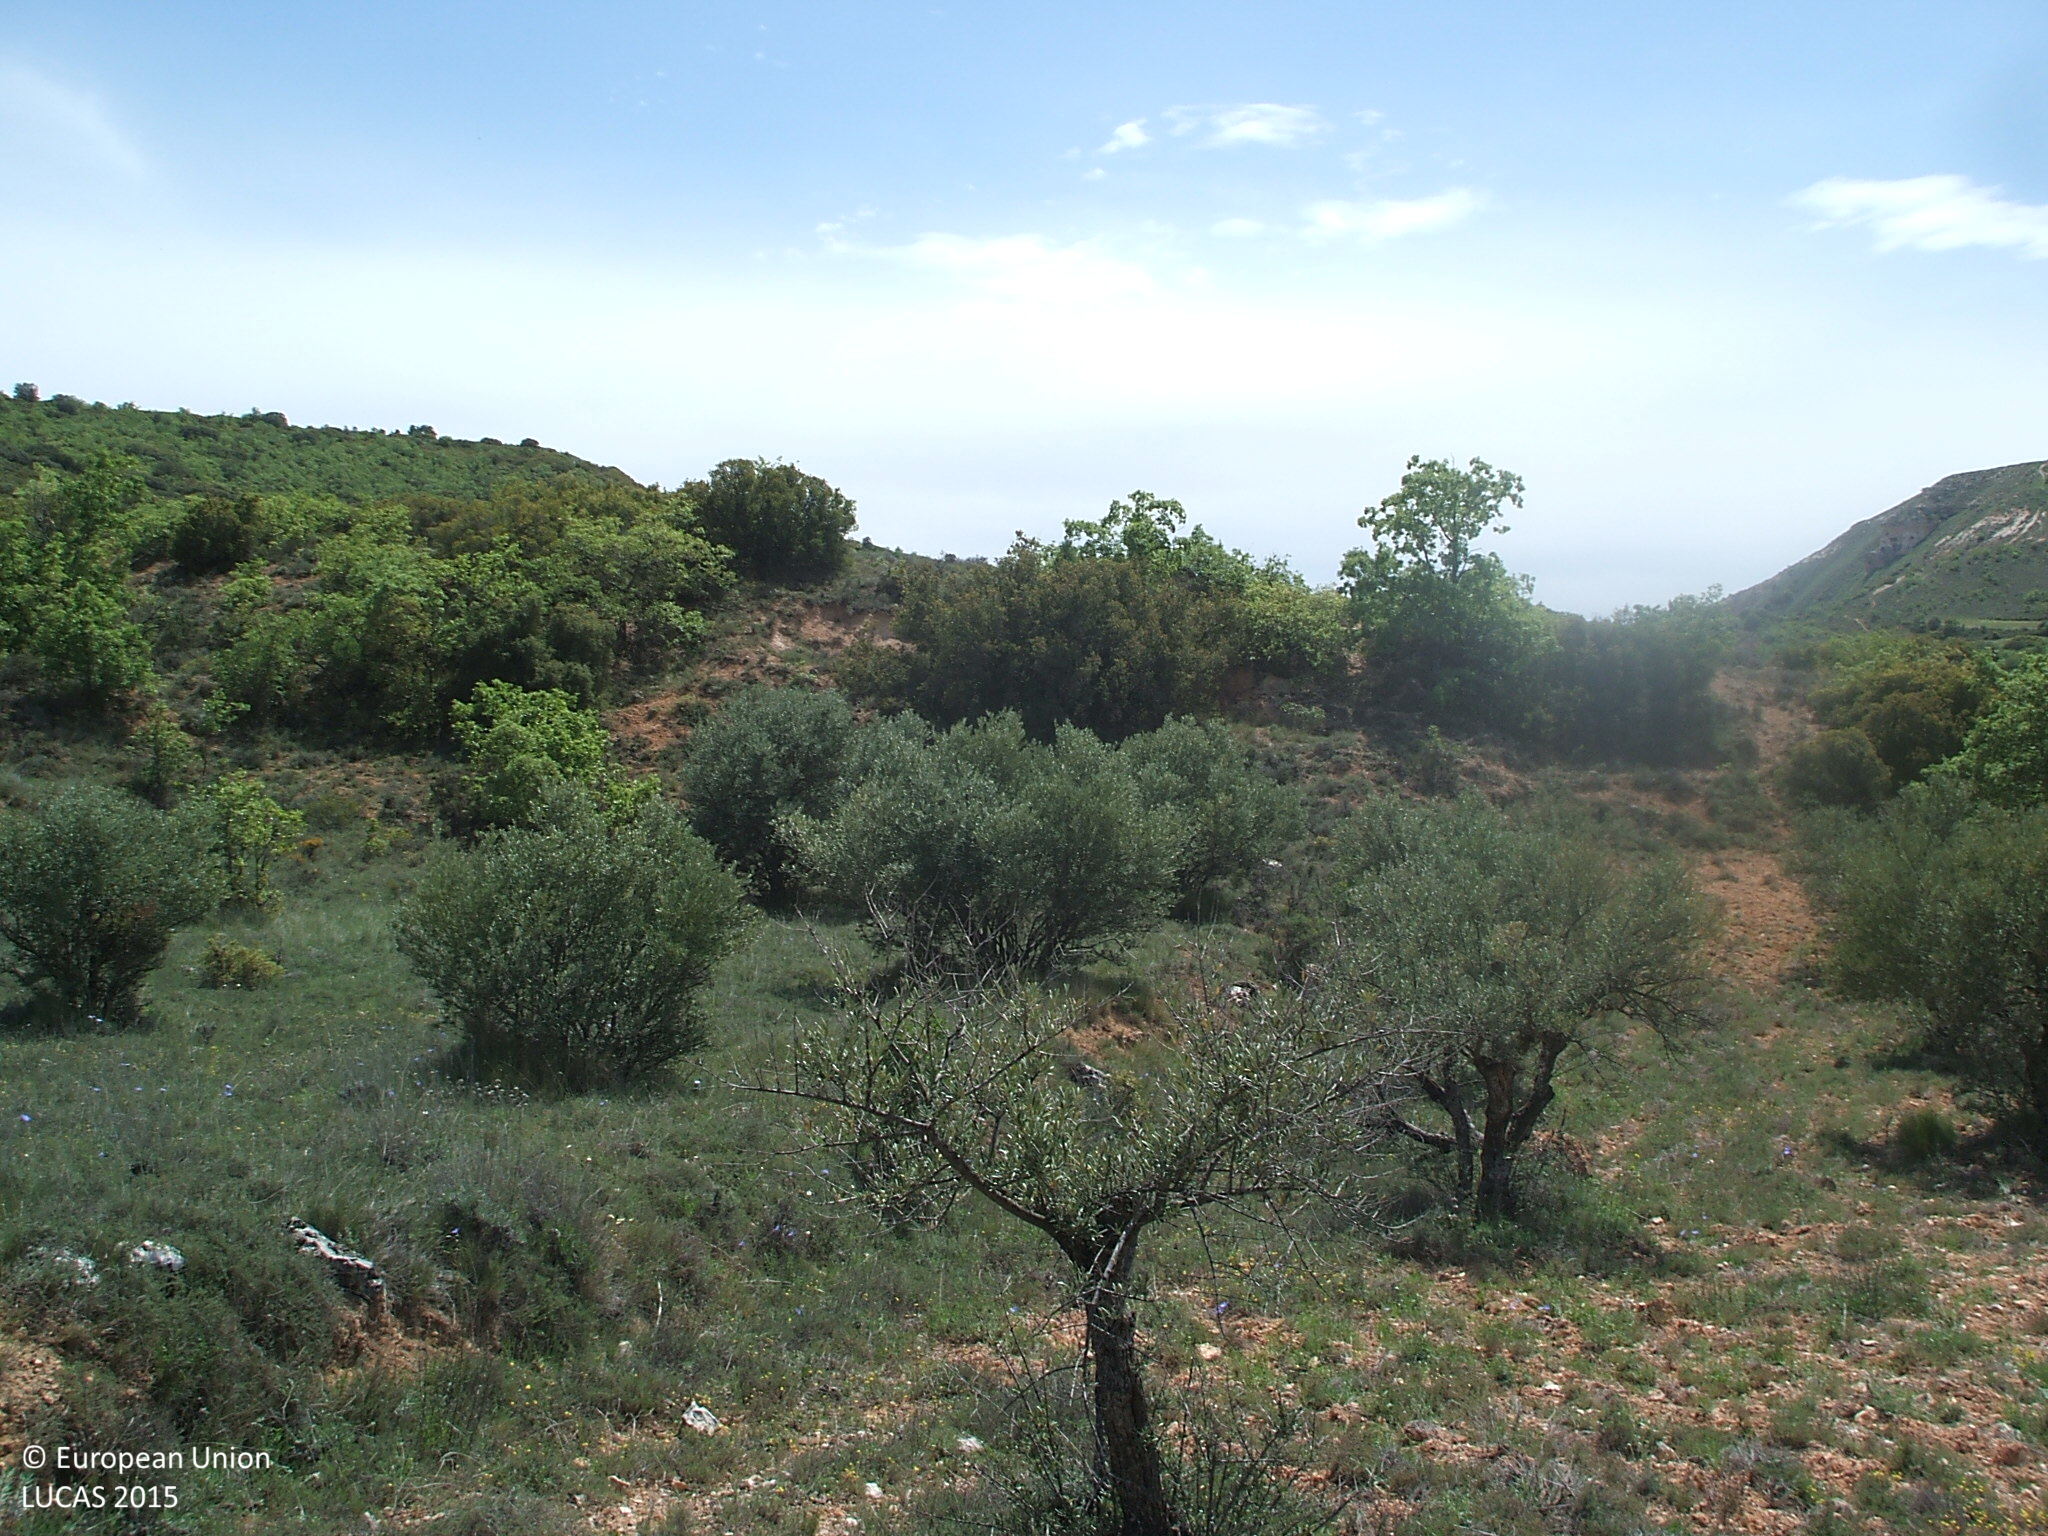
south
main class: Cropland
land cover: Olive groves
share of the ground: 25 - 50 %
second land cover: Grassland without tree/shrub cover
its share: 25 - 50 %
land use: Agriculture (excluding fallow land and kitchen gardens)
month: May
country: ES
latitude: 40.8439
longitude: -2.9975
